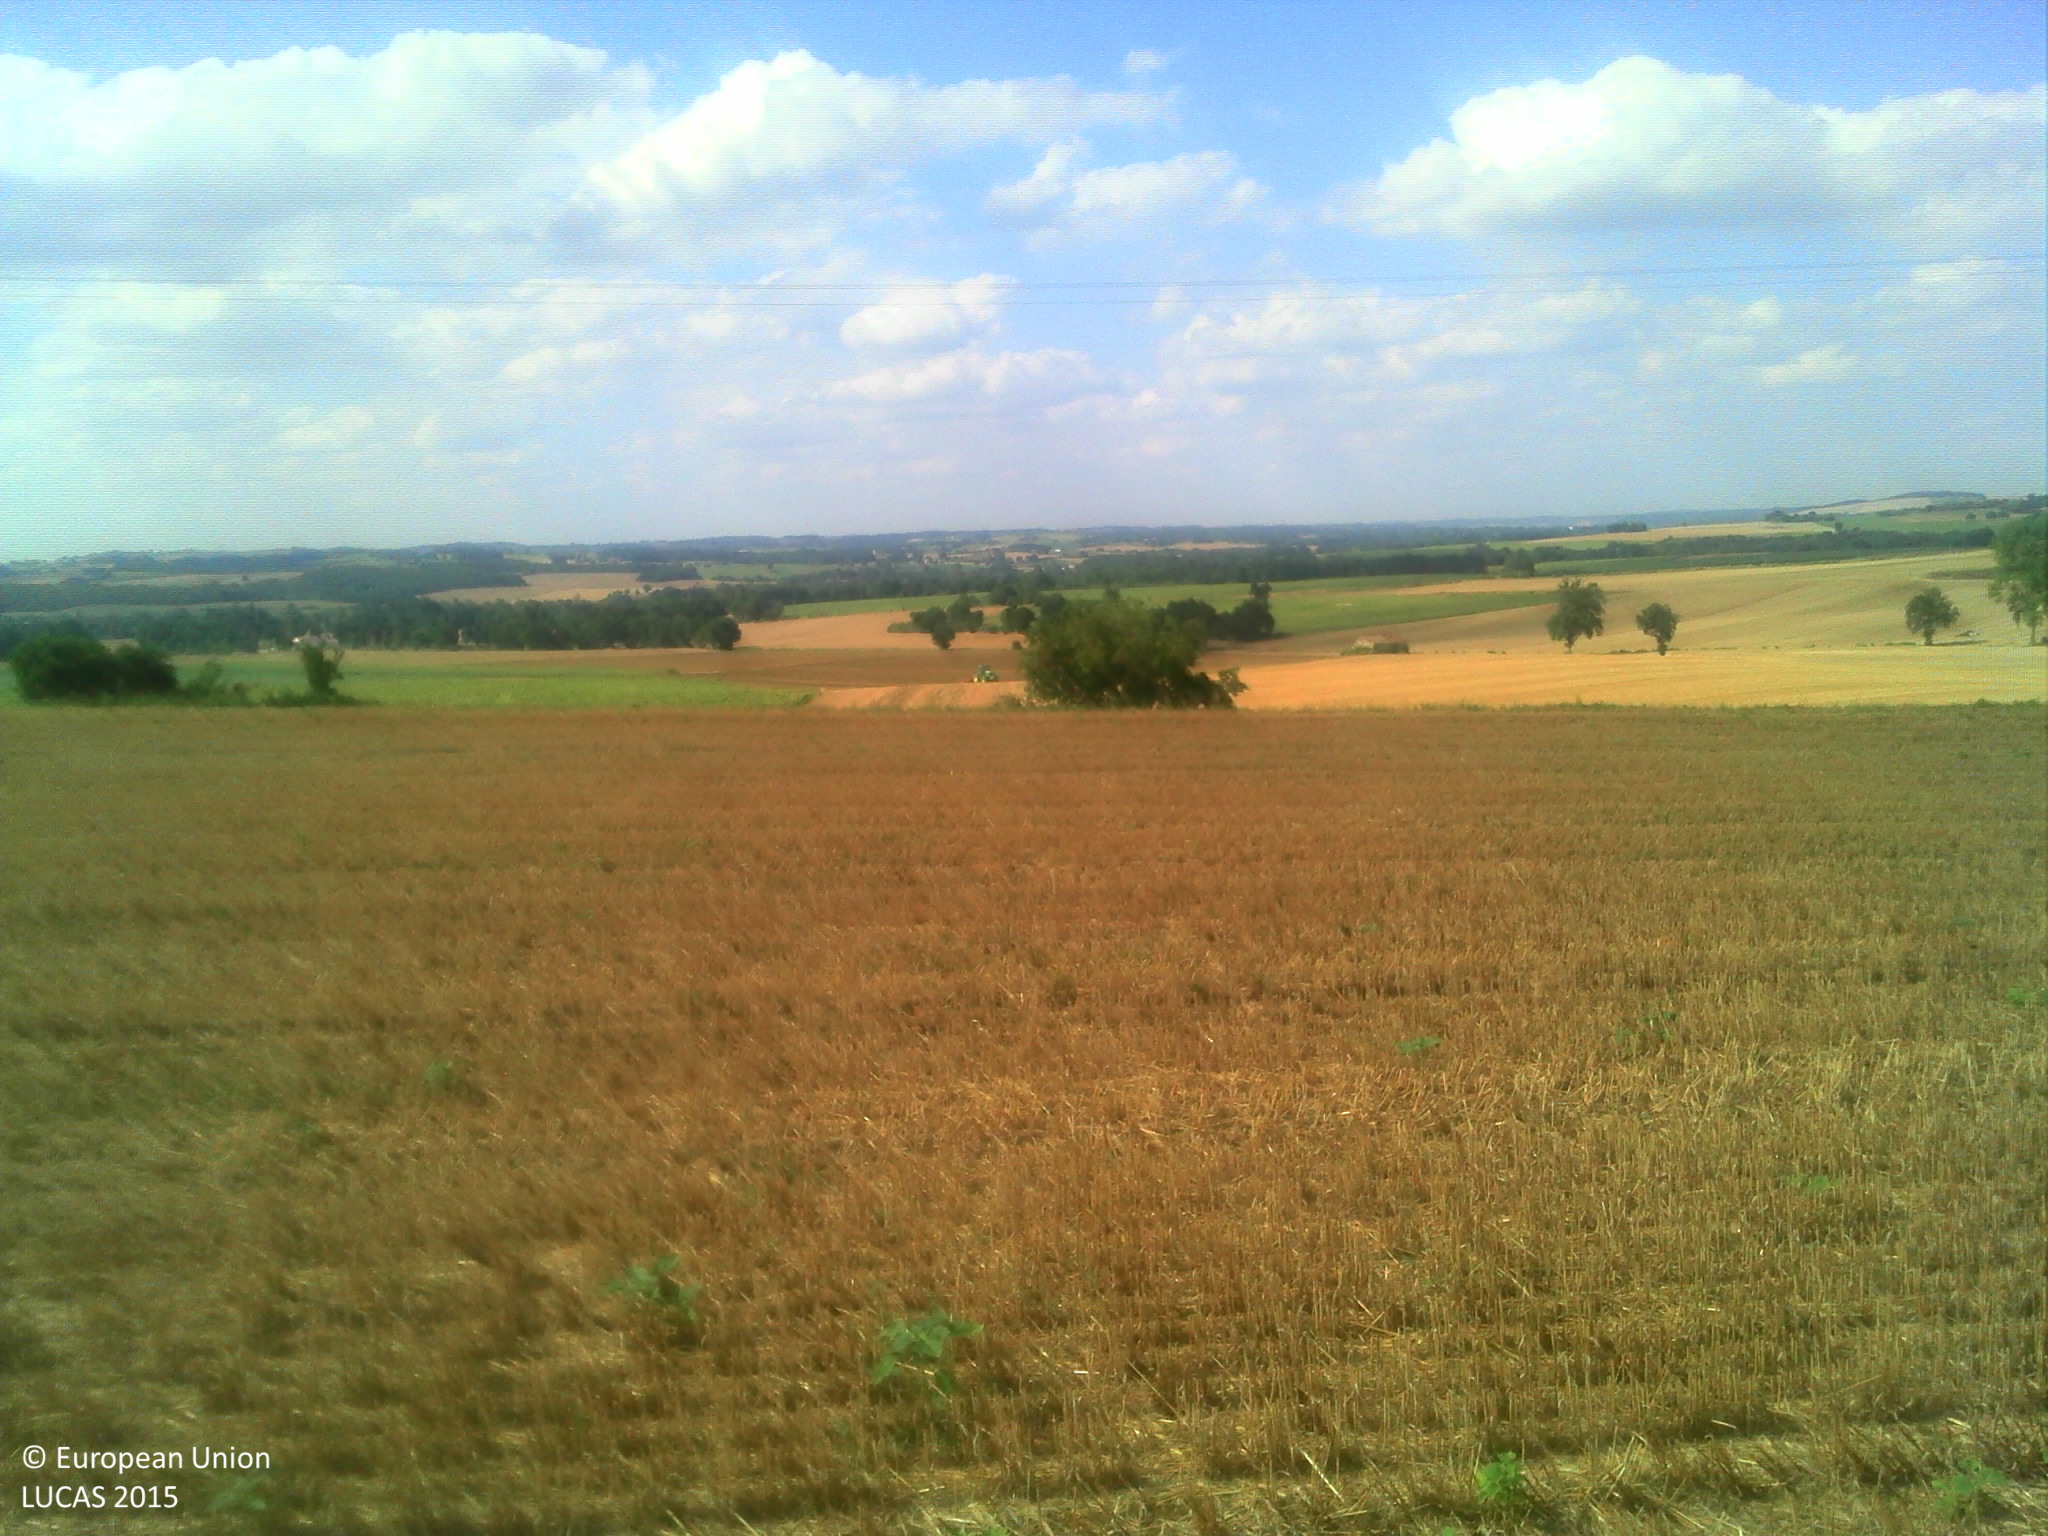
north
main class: Cropland
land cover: Common wheat
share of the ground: > 75 %
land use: Agriculture (excluding fallow land and kitchen gardens)
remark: Harvested field
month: July
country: FR
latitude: 44.0163
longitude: 0.6276
